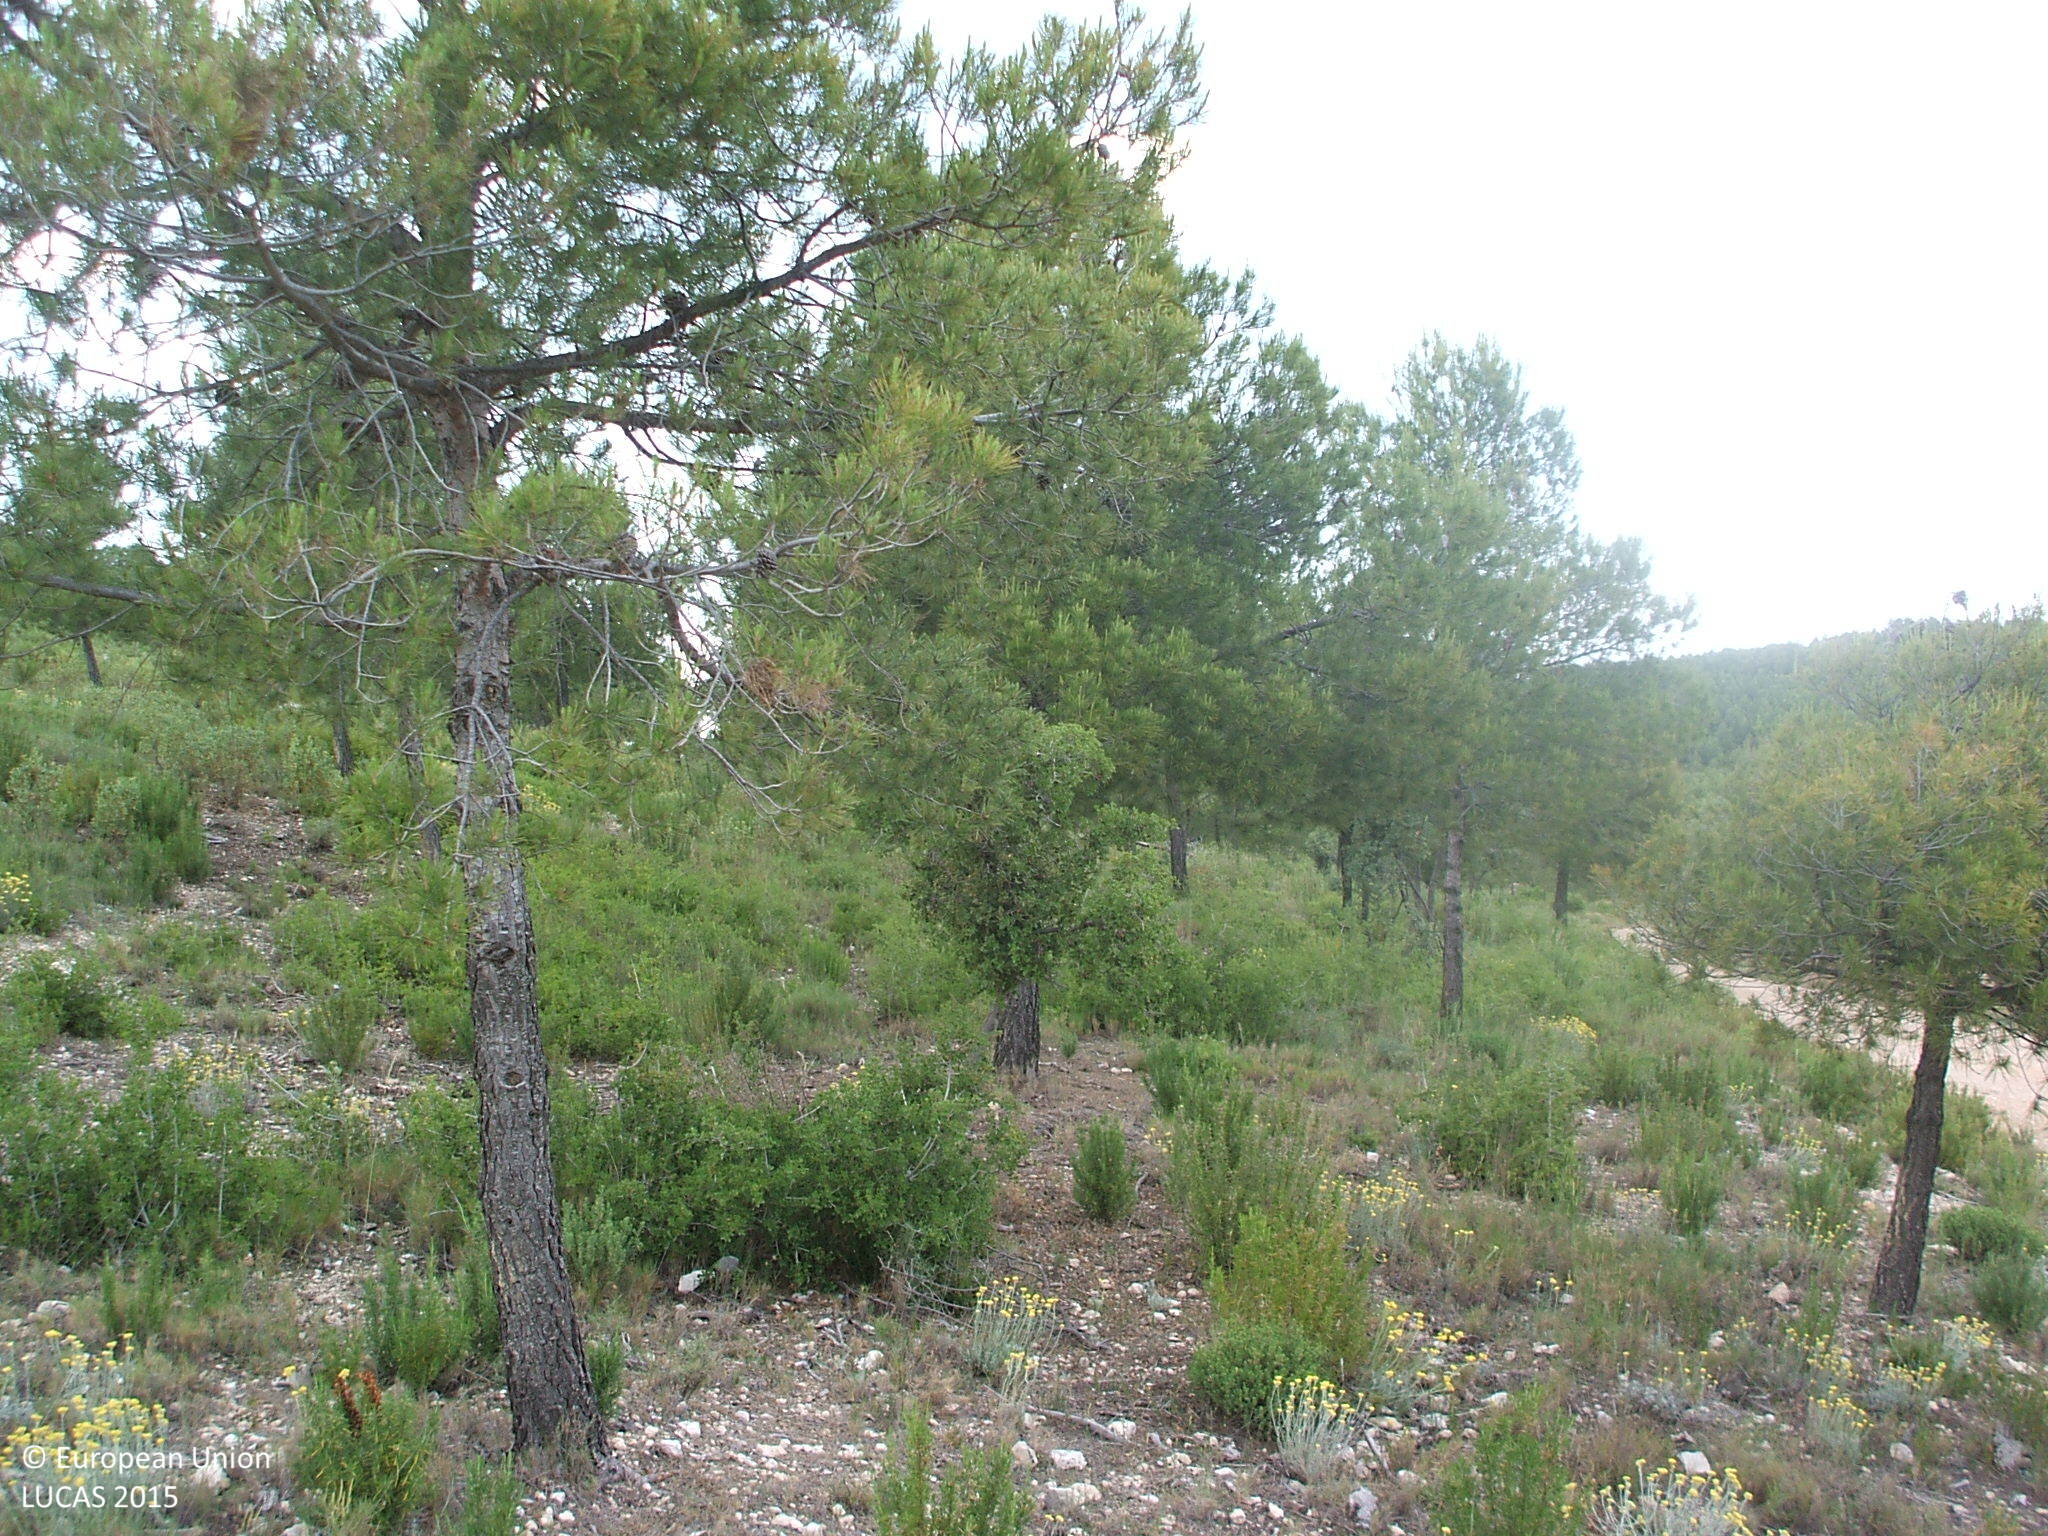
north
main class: Woodland
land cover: Pine dominated coniferous woodland
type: coniferous forest of the mediterranean region
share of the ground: > 75 %
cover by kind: coniferous forest trees 100 %
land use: Semi-natural and natural areas not in use
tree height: > 5 m
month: June
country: ES
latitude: 40.8865
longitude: -0.1573
